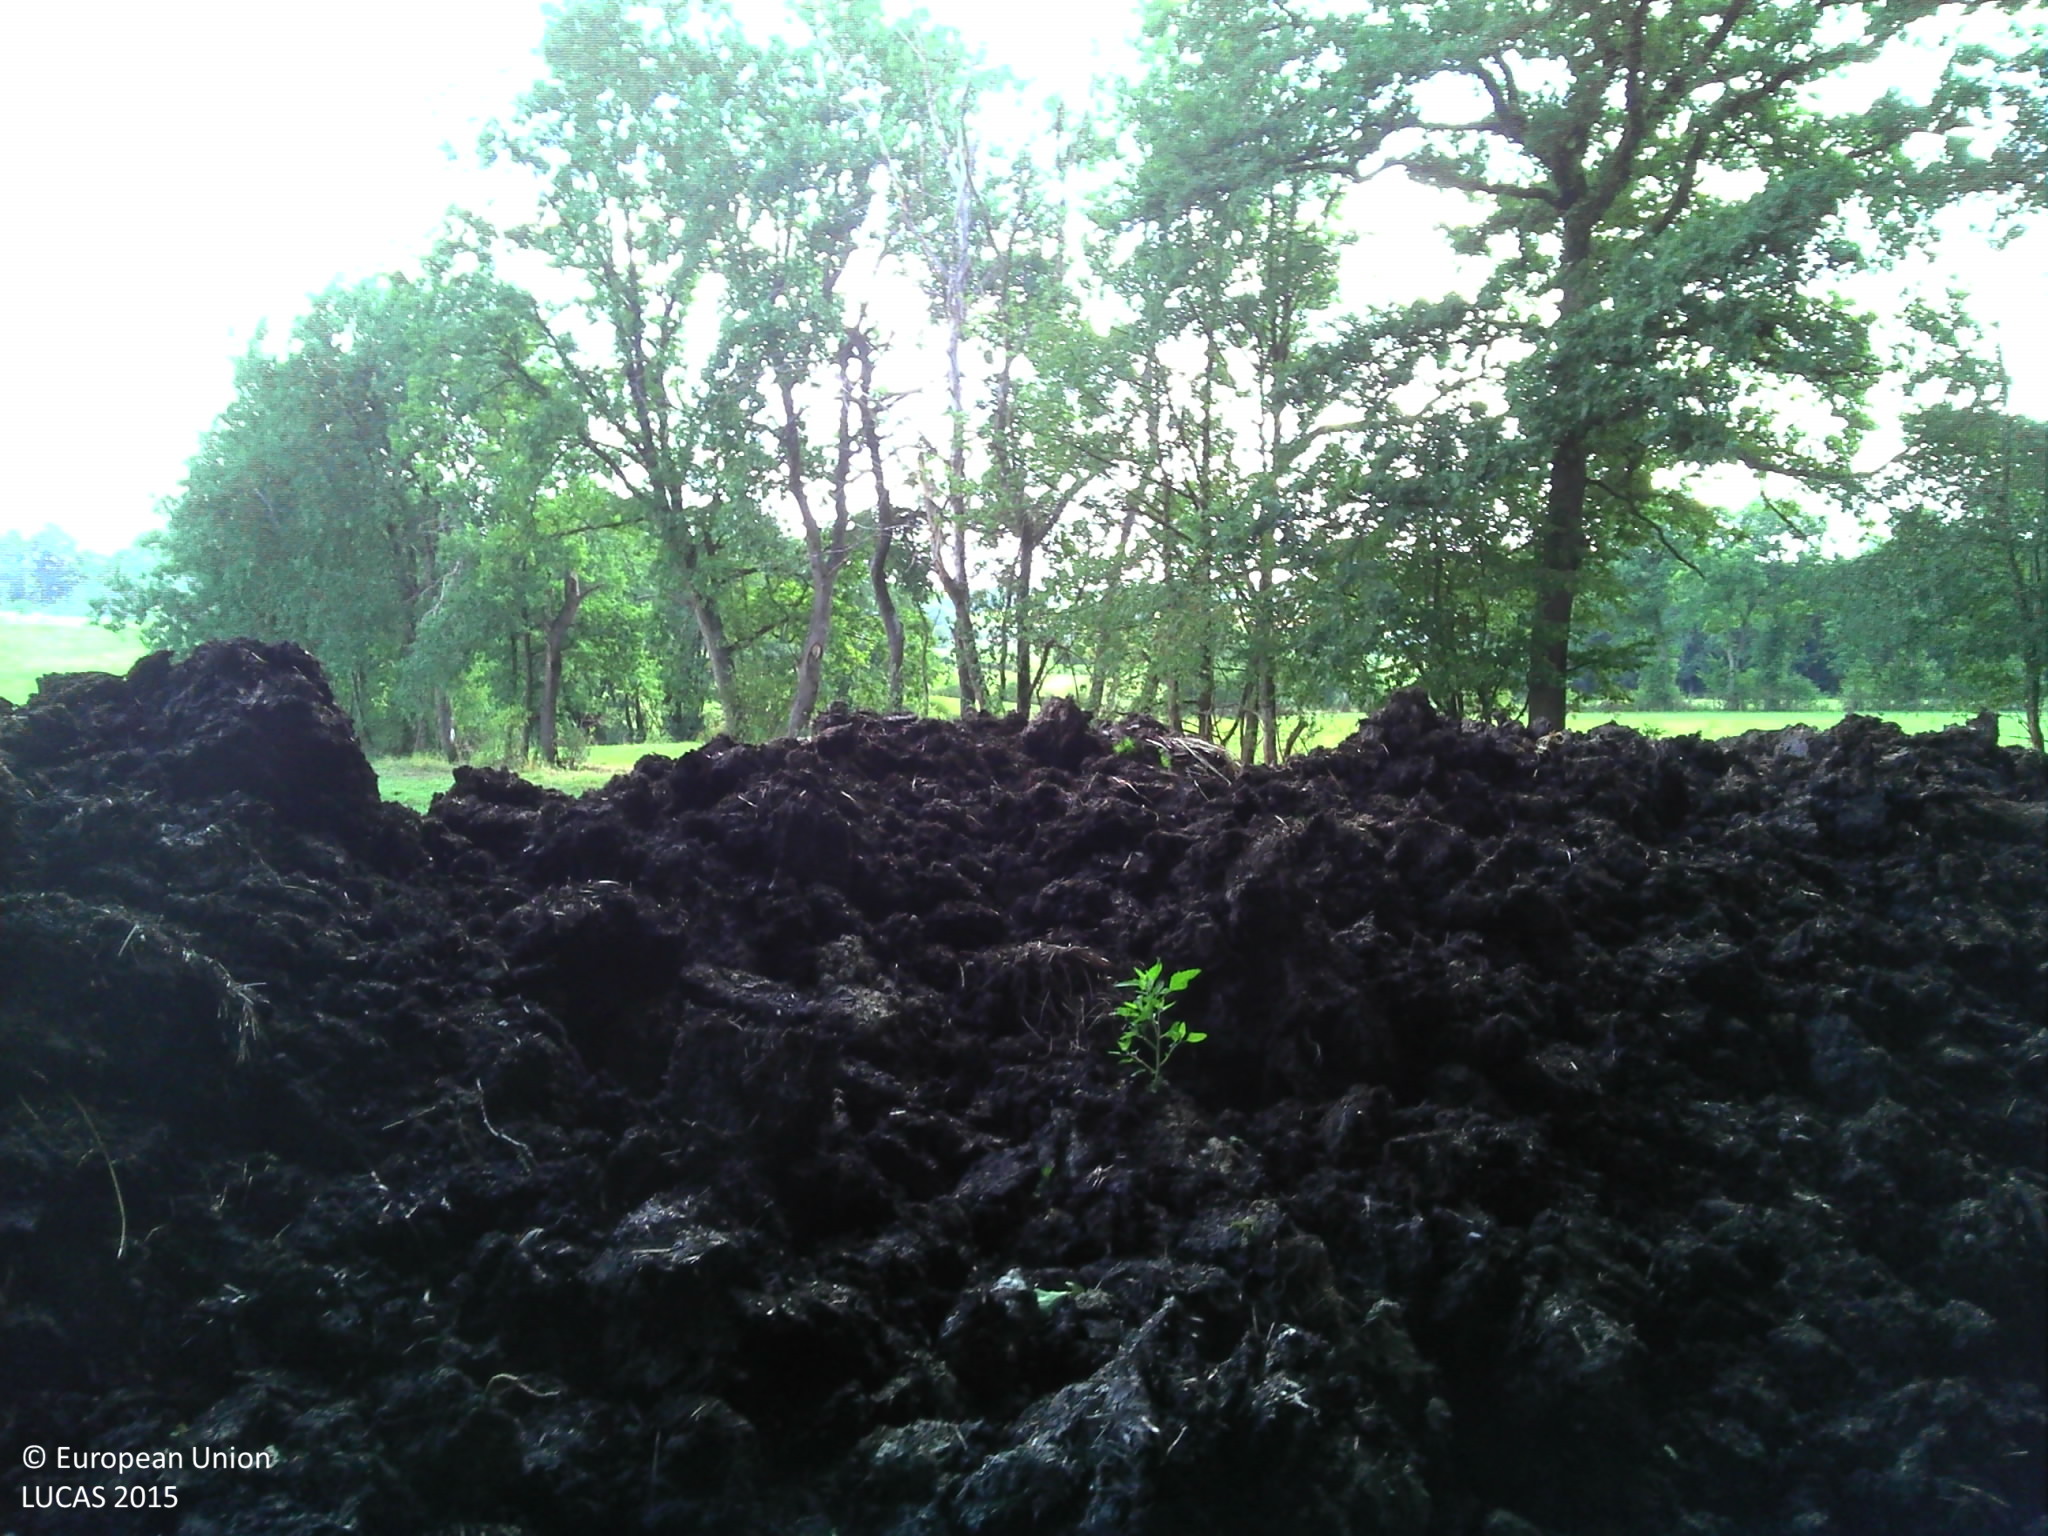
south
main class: Woodland
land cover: Broadleaved woodland
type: mesophytic deciduous forest
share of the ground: > 75 %
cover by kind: broadleaved forest trees 70 %, shrubs 30 %
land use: Forestry
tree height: > 5 m
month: July
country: BE
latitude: 50.0823
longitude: 4.3916
